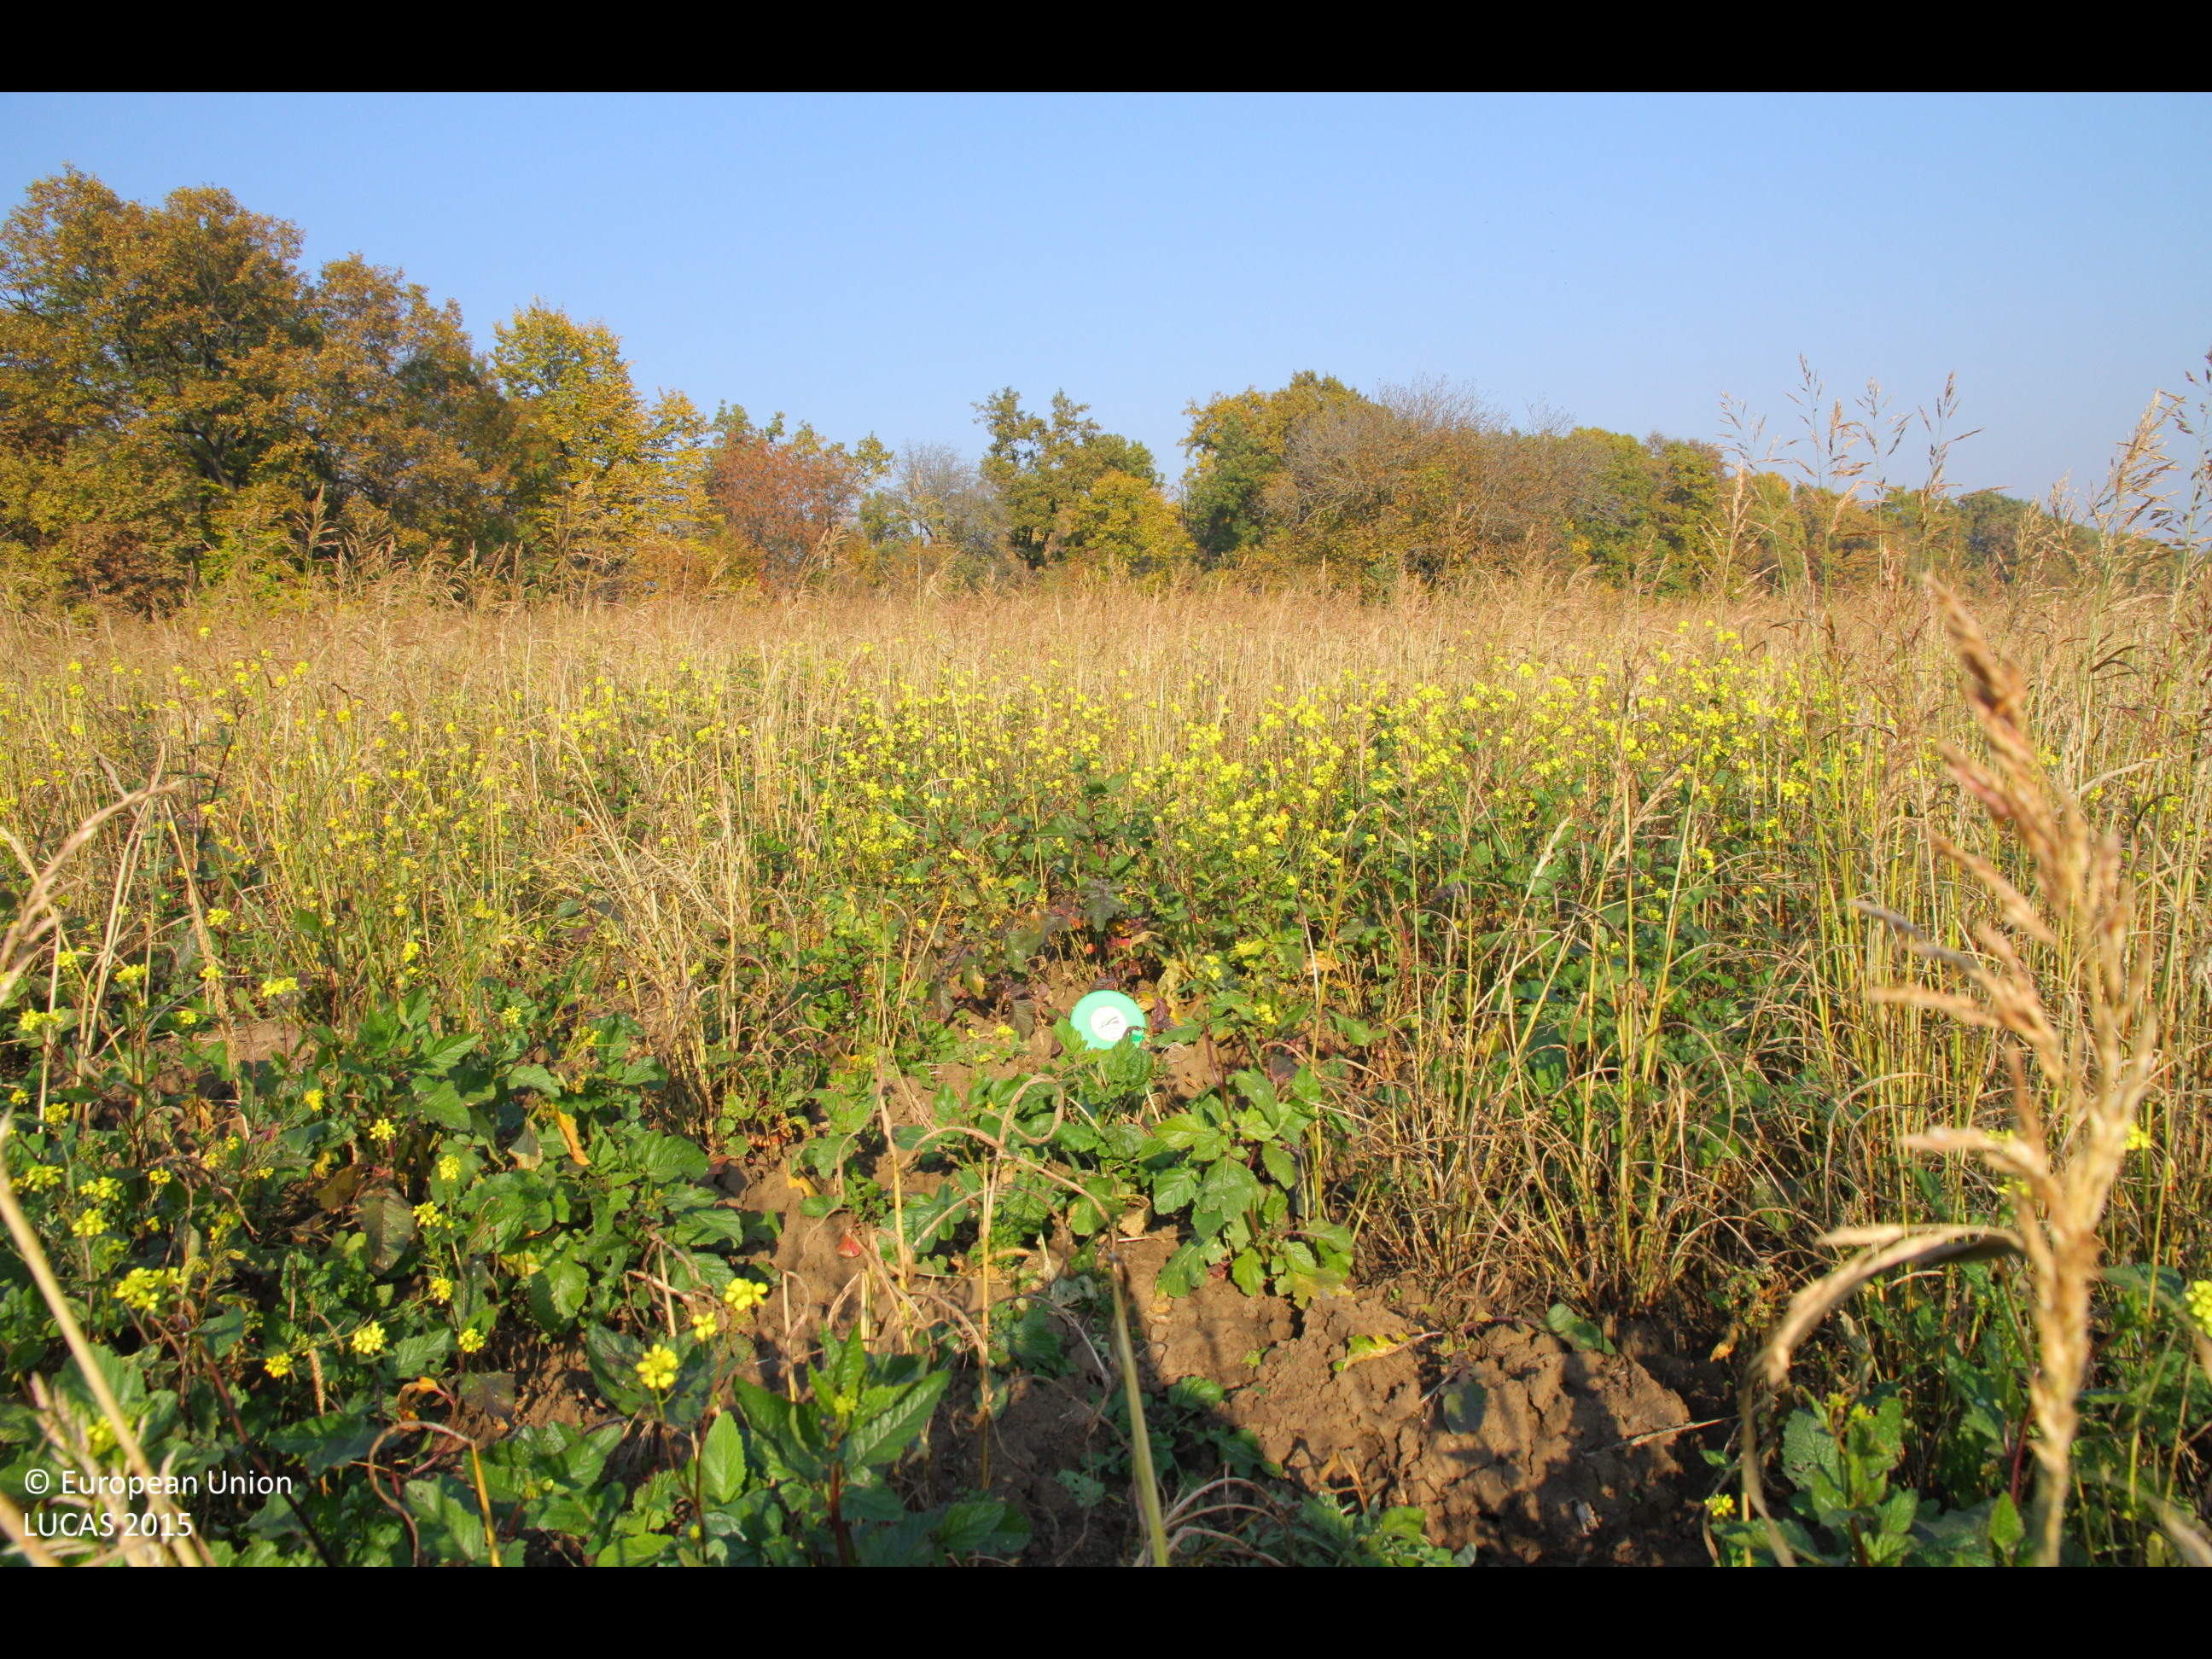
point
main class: Cropland
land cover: Rape and turnip rape
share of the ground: > 75 %
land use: Agriculture (excluding fallow land and kitchen gardens)
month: November
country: BG
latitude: 43.7050
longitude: 26.3473
